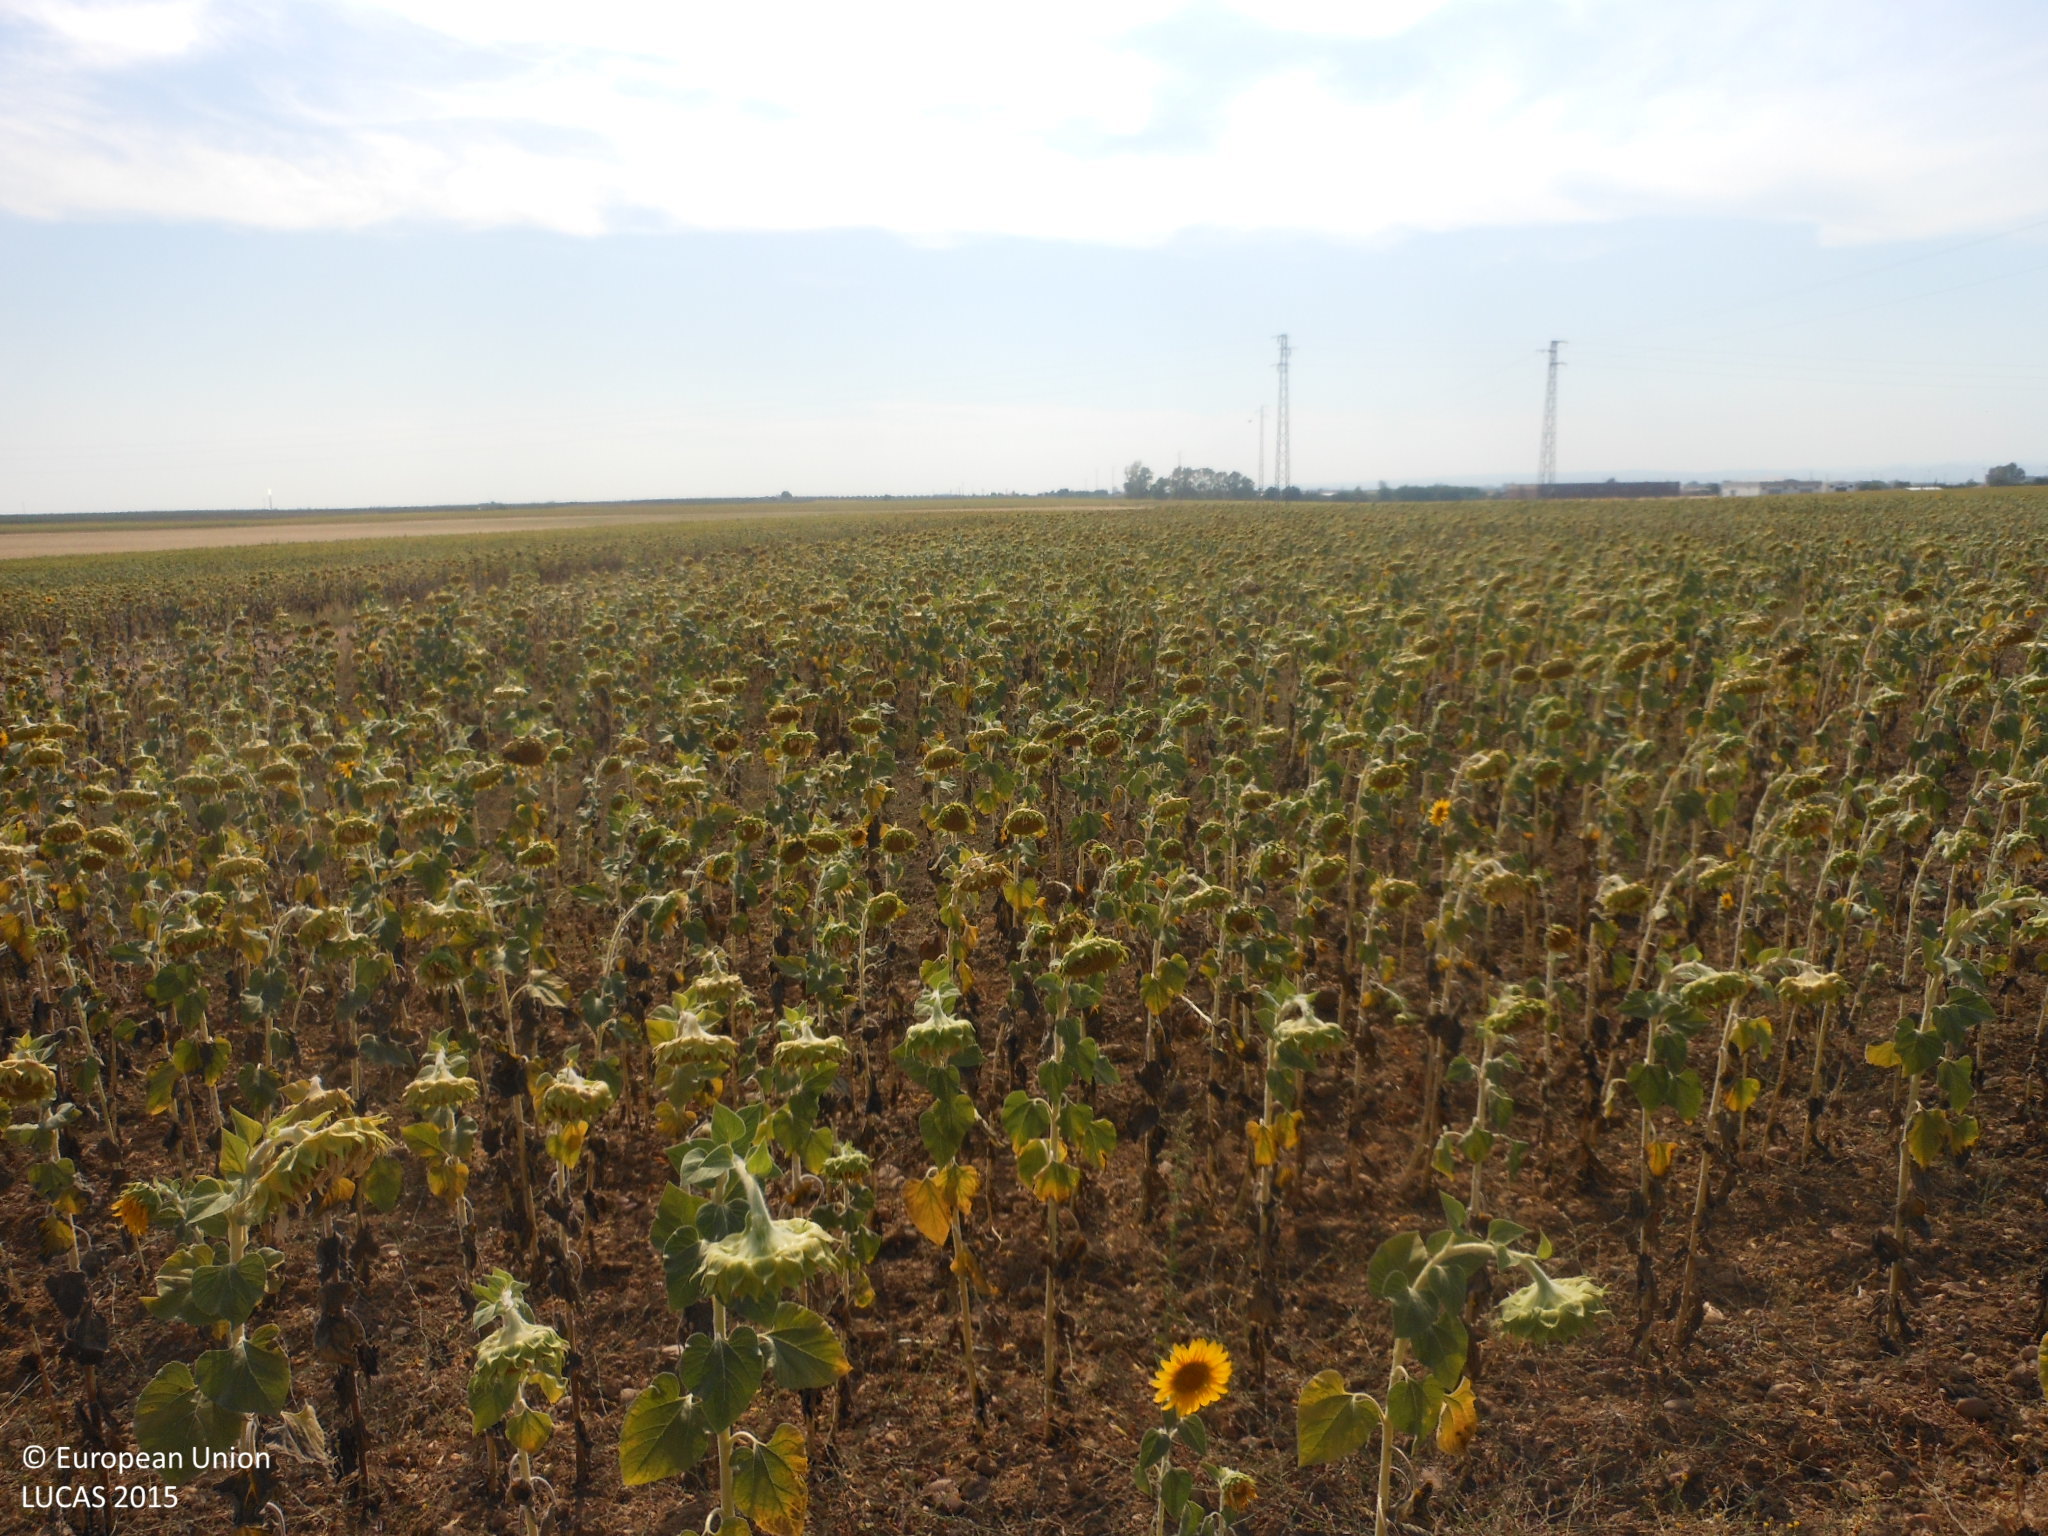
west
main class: Cropland
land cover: Sunflower
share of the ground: > 75 %
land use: Agriculture (excluding fallow land and kitchen gardens)
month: June
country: ES
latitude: 37.5855
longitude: -5.2012
